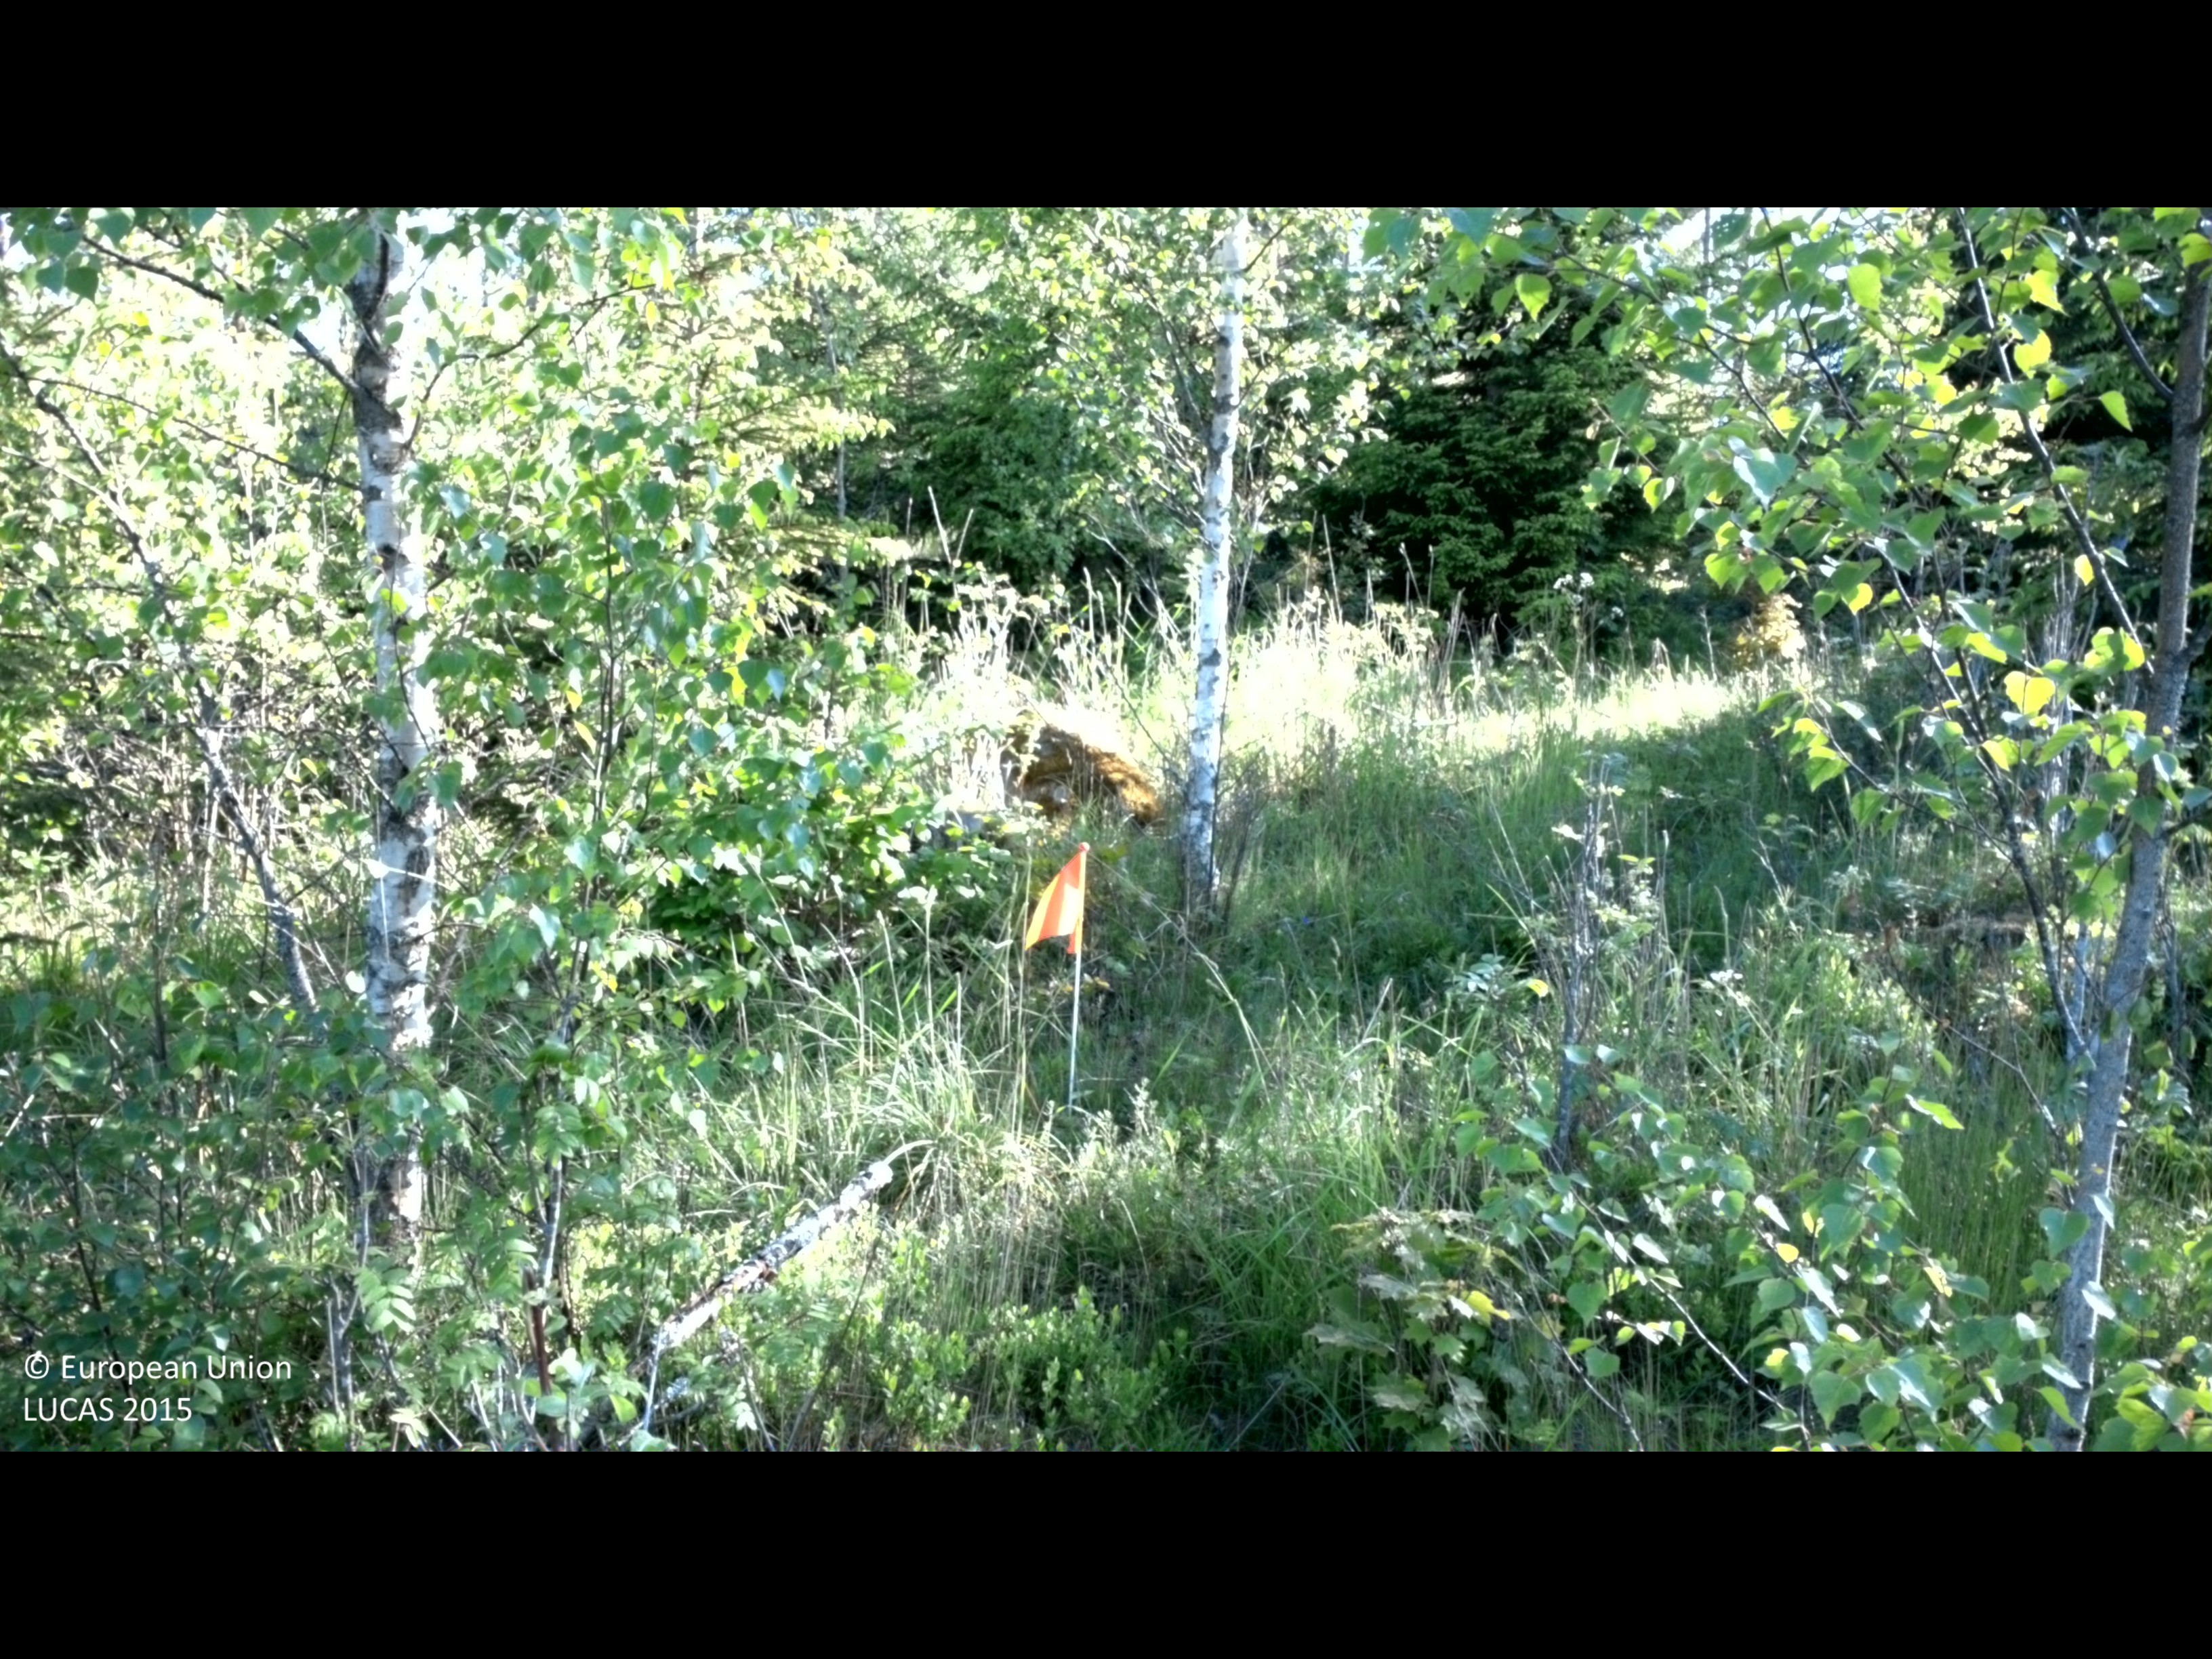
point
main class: Woodland
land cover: Spruce dominated mixed woodland
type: hemiboreal forest and nemoral coniferous forest and mixed broadleaved-coniferous forest
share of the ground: 25 - 50 %
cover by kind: herbaceous plants 40 %, shrubs 25 %, coniferous forest trees 20 %, broadleaved forest trees 15 %
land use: Forestry
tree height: > 5 m
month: June
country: SE
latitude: 57.8413
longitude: 16.2131
